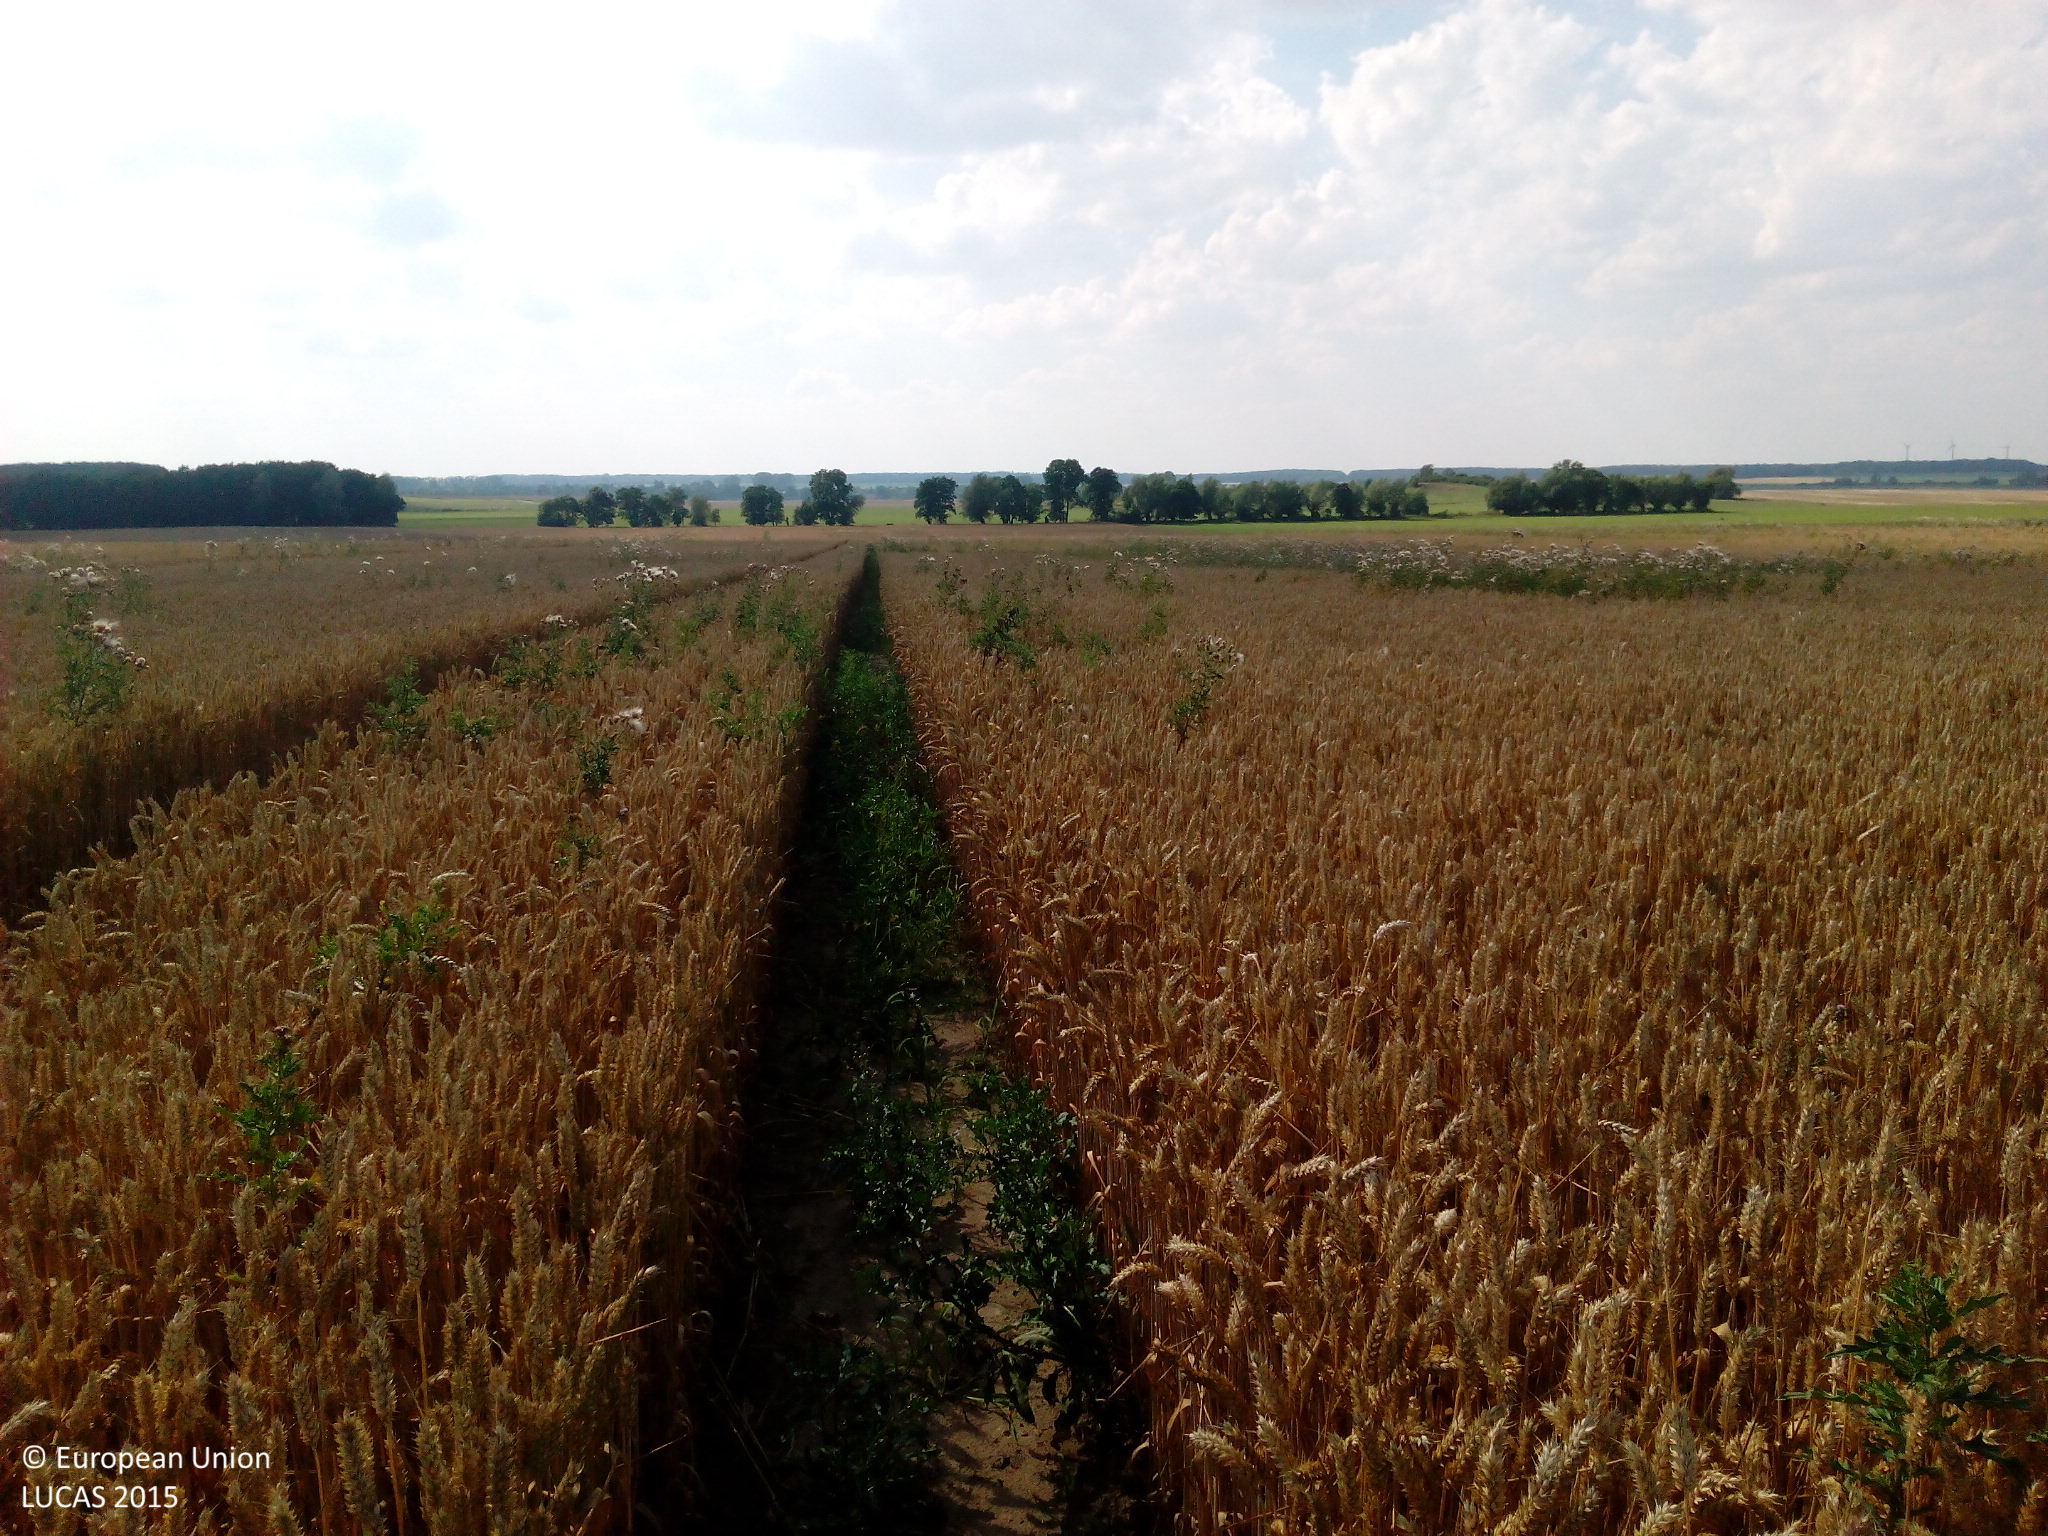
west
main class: Cropland
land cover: Common wheat
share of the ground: > 75 %
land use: Agriculture (excluding fallow land and kitchen gardens)
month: August
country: DE
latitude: 53.5821
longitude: 13.6099
